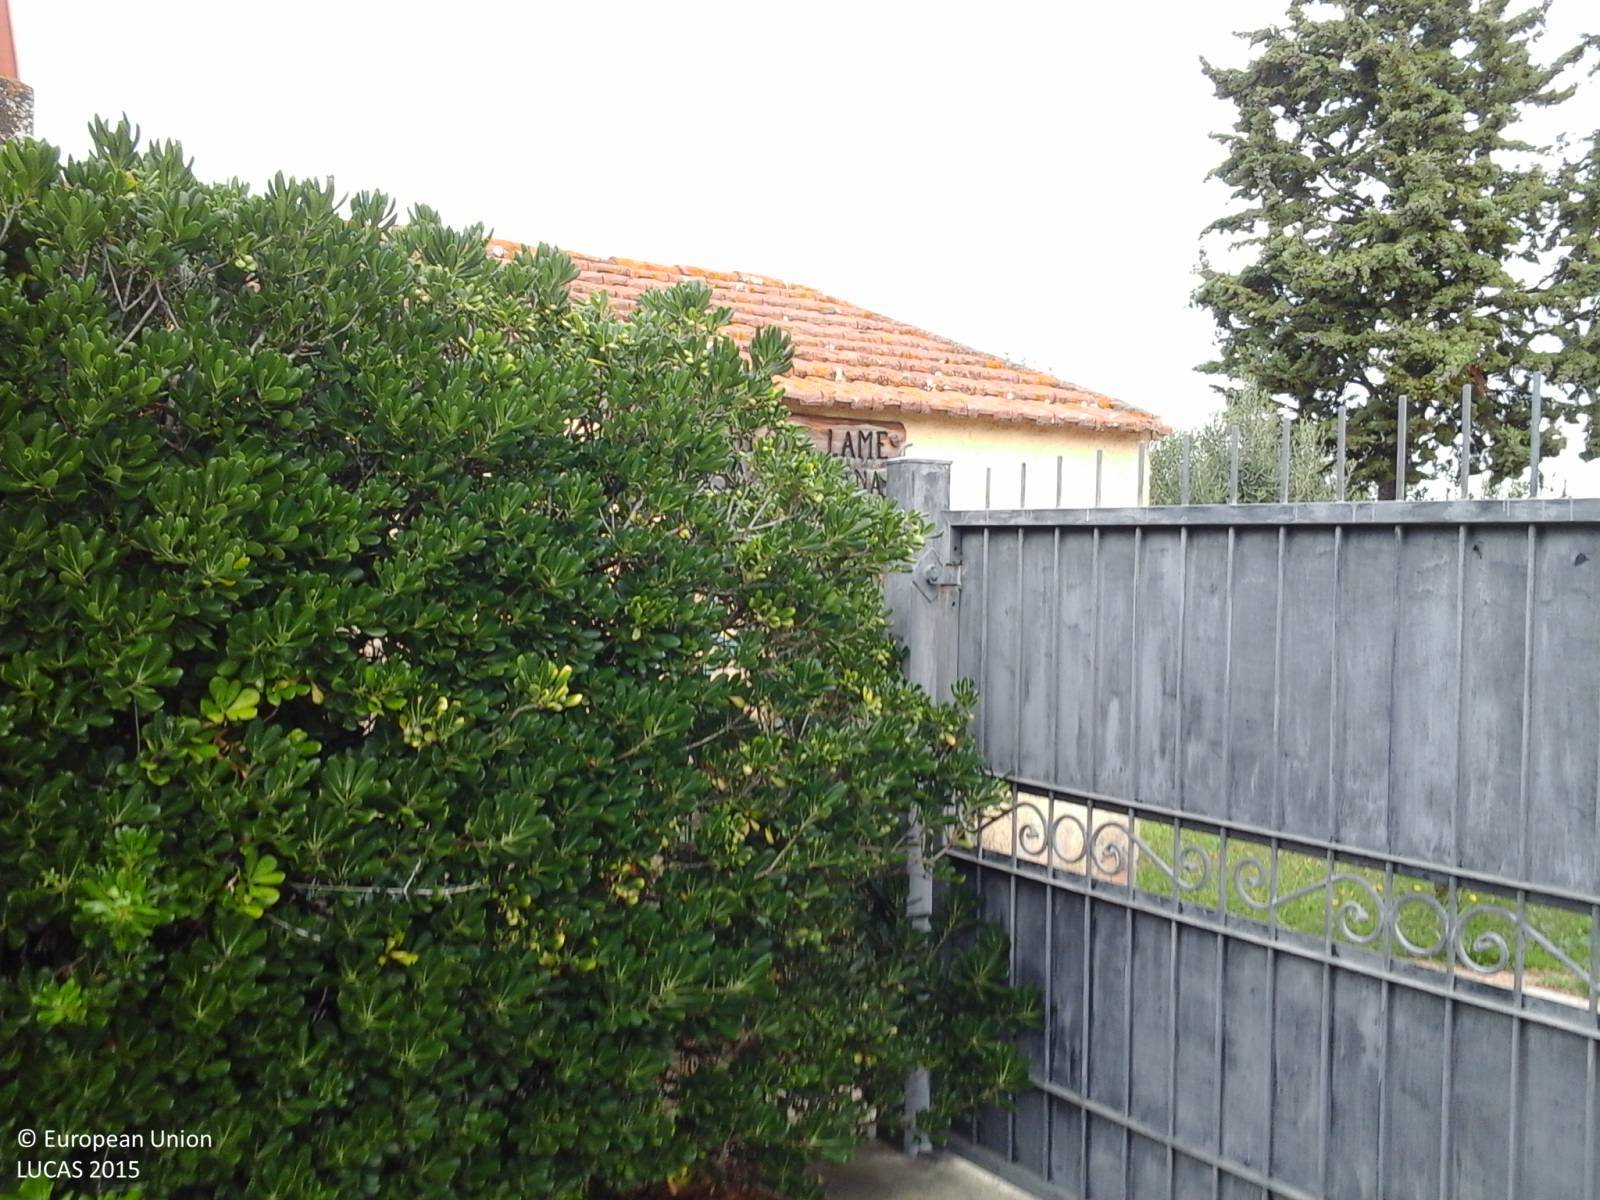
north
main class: Grassland
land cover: Grassland with sparse tree/shrub cover
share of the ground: 25 - 50 %
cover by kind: herbaceous plants 90 %, broadleaved forest trees 5 %, shrubs 5 %
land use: Residential
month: October
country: IT
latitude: 43.1759
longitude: 10.6010
